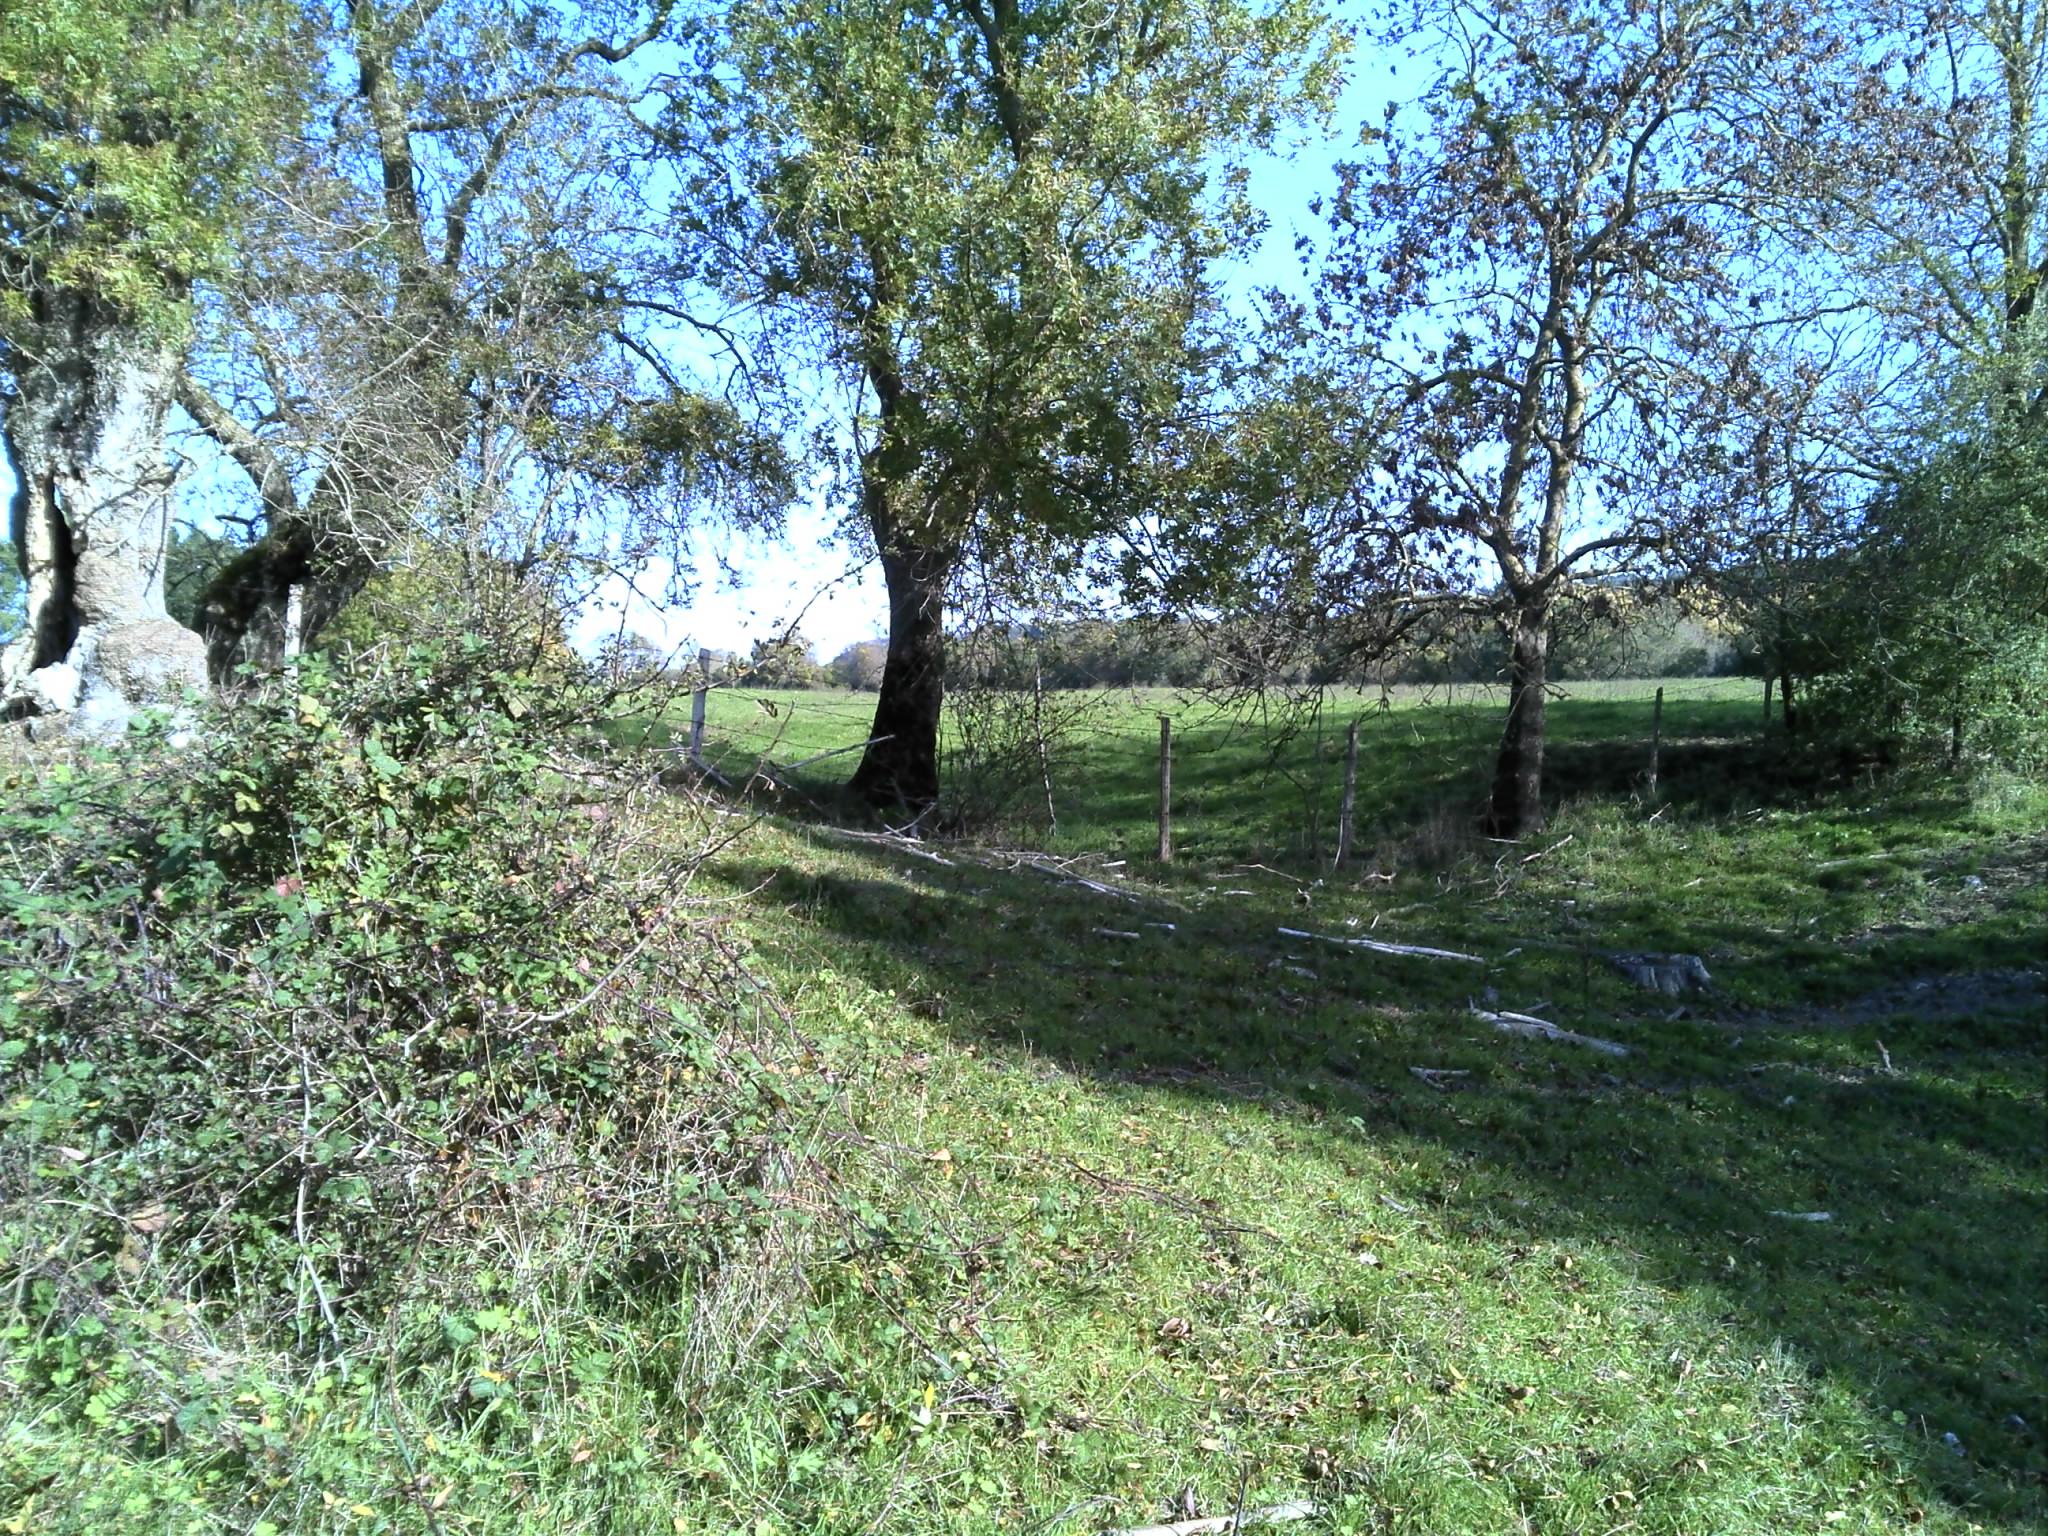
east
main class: Grassland
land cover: Grassland without tree/shrub cover
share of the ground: > 75 %
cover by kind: herbaceous plants 100 %
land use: Agriculture (excluding fallow land and kitchen gardens)
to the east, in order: Grassland without tree/shrub cover; Fences; Broadleaved woodland; Grassland without tree/shrub cover
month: October
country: FR
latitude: 47.3315
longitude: -1.3008
